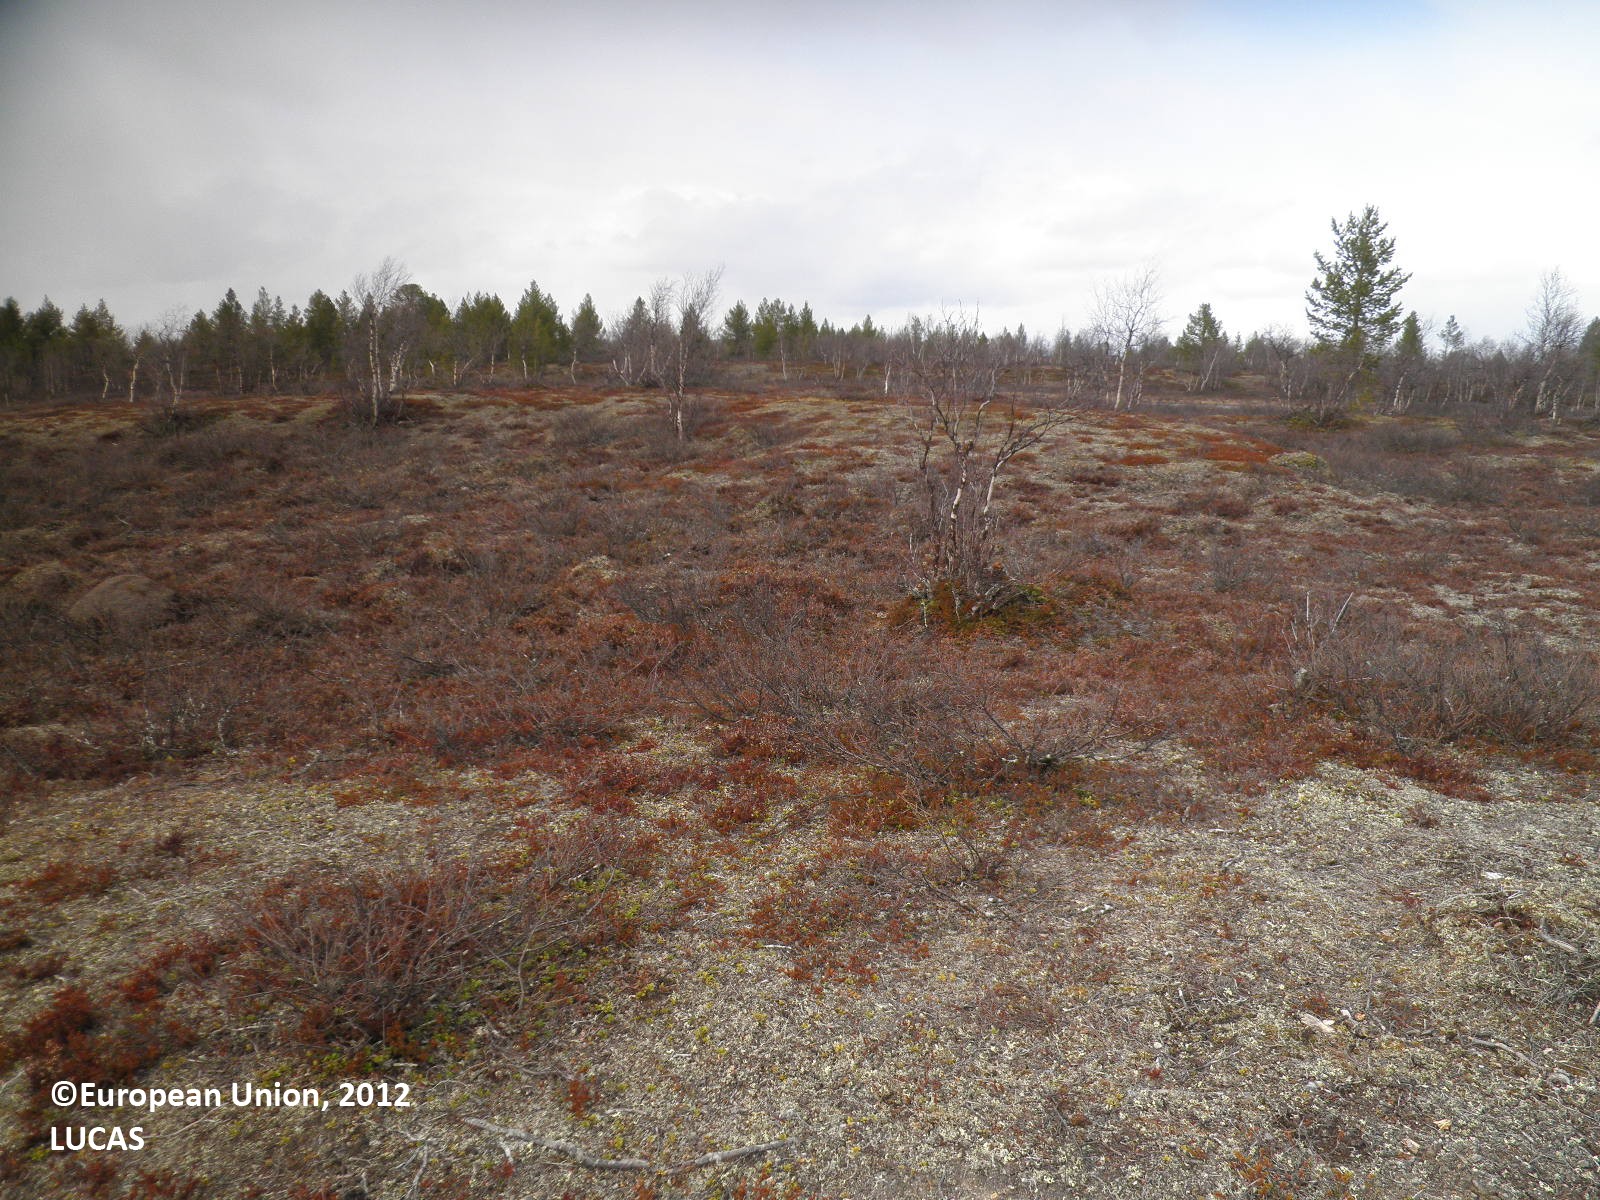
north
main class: Shrubland
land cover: Shrubland with sparse tree cover
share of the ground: 25 - 50 %
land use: Forestry
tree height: < 5 m
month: May
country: FI
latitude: 69.3220
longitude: 26.6124
